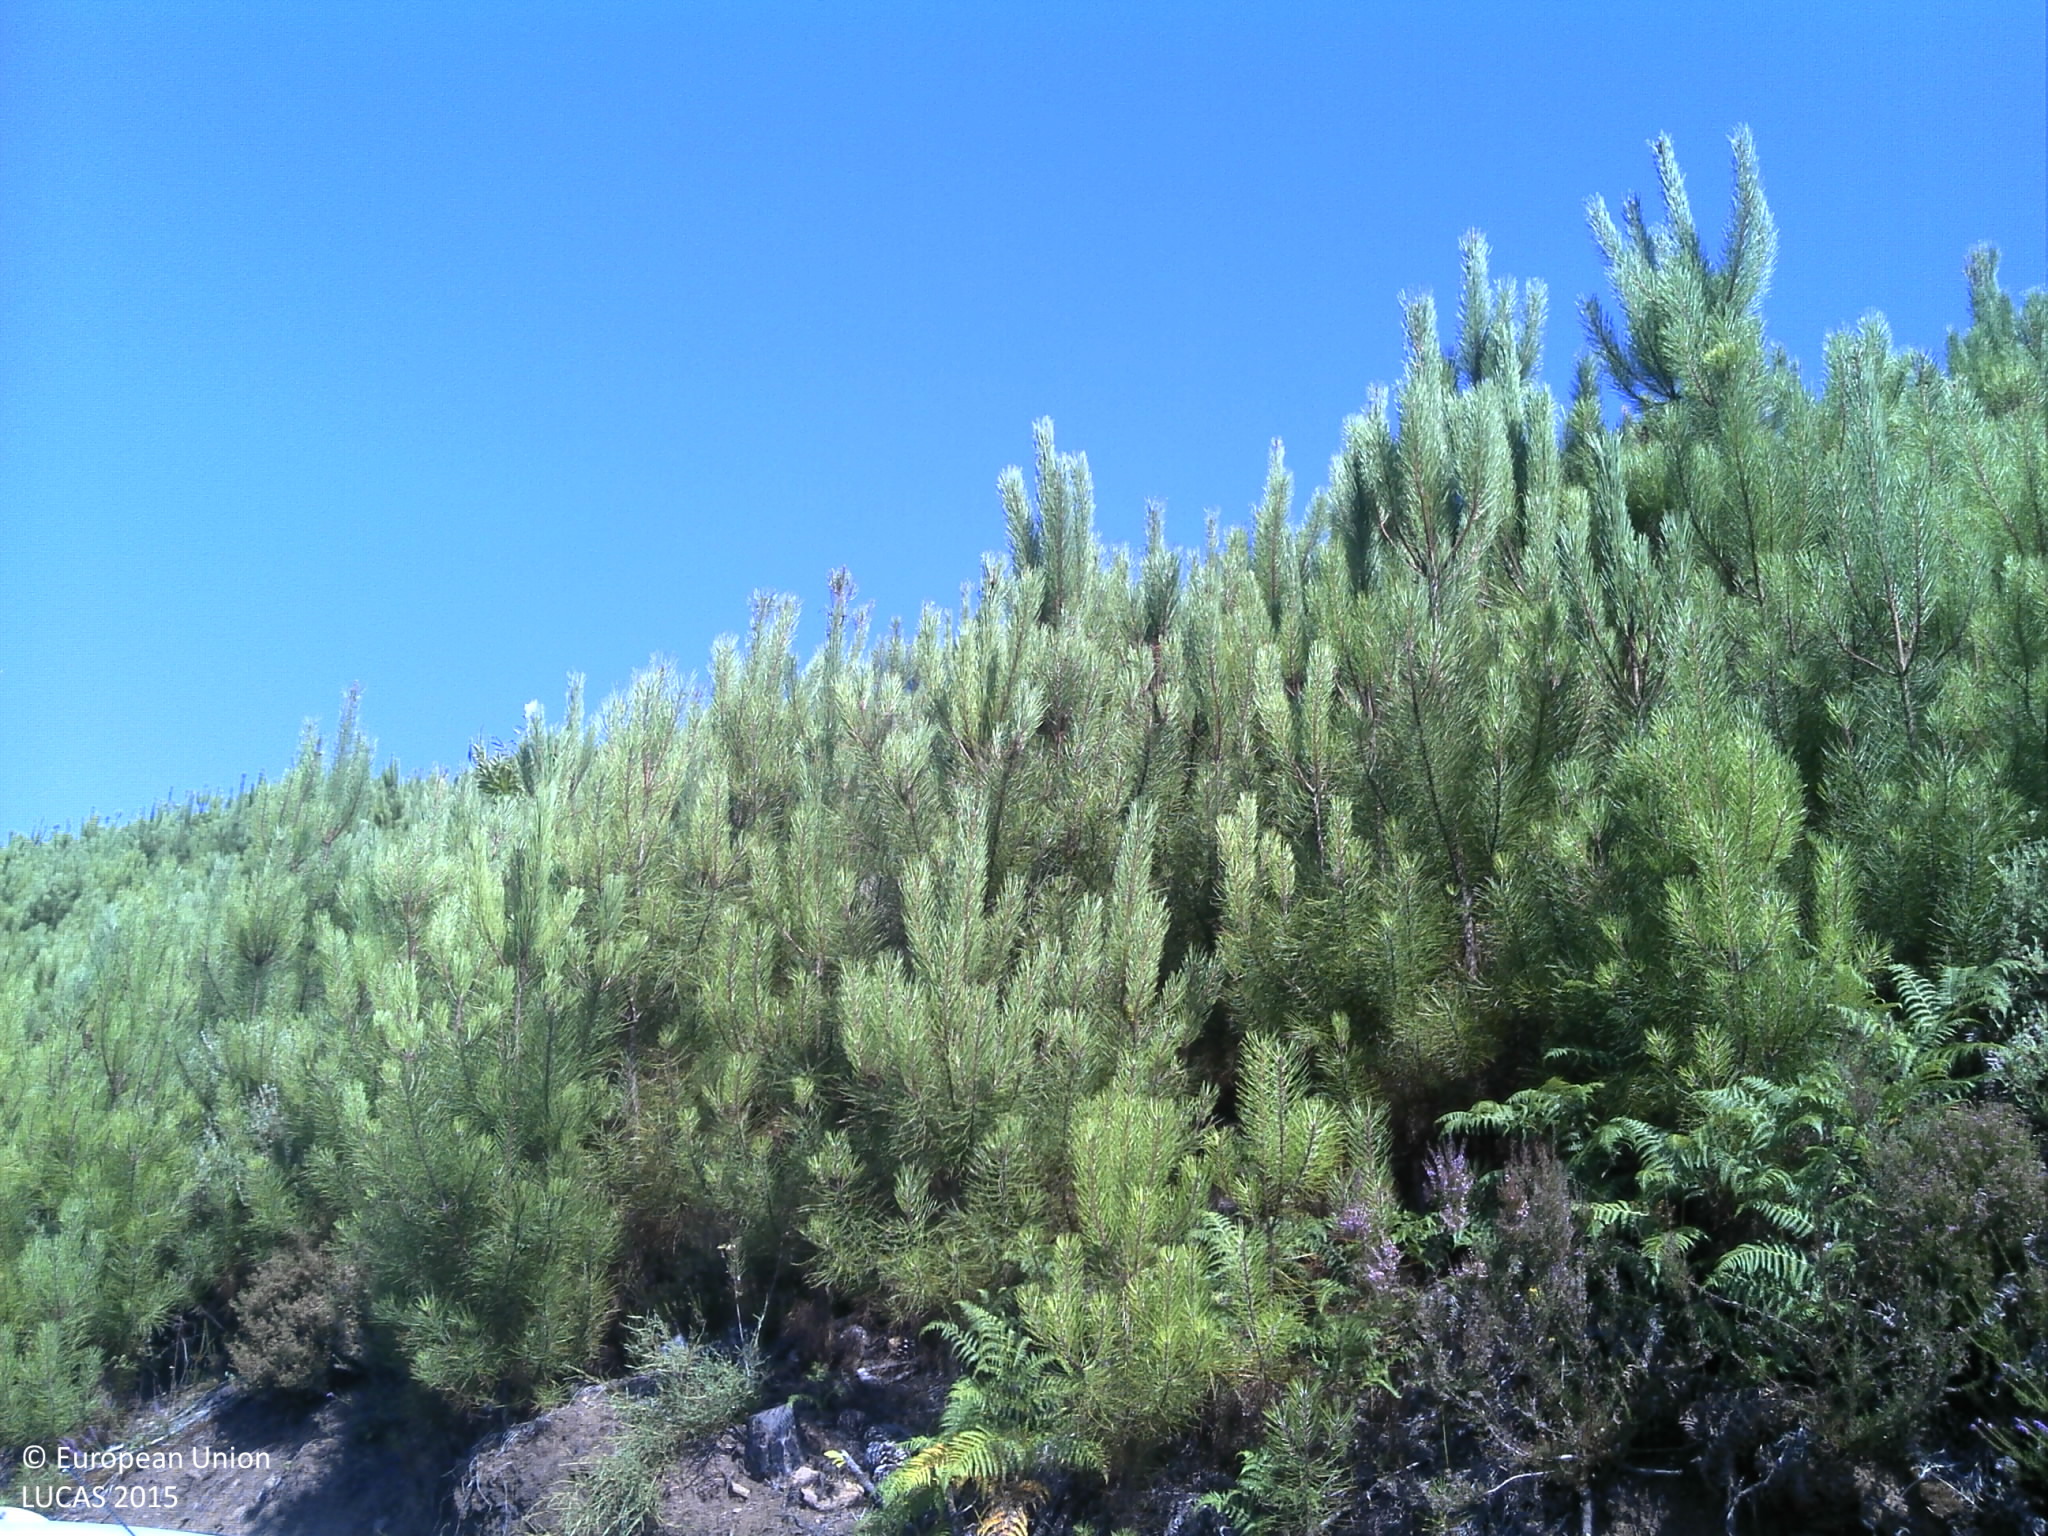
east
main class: Woodland
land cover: Pine dominated coniferous woodland
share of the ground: 50 - 75 %
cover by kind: coniferous forest trees 70 %, shrubs 30 %
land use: Forestry
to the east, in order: Pine dominated coniferous woodland; Tracks; Pine dominated coniferous woodland
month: July
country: PT
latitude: 40.3147
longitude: -7.8503
